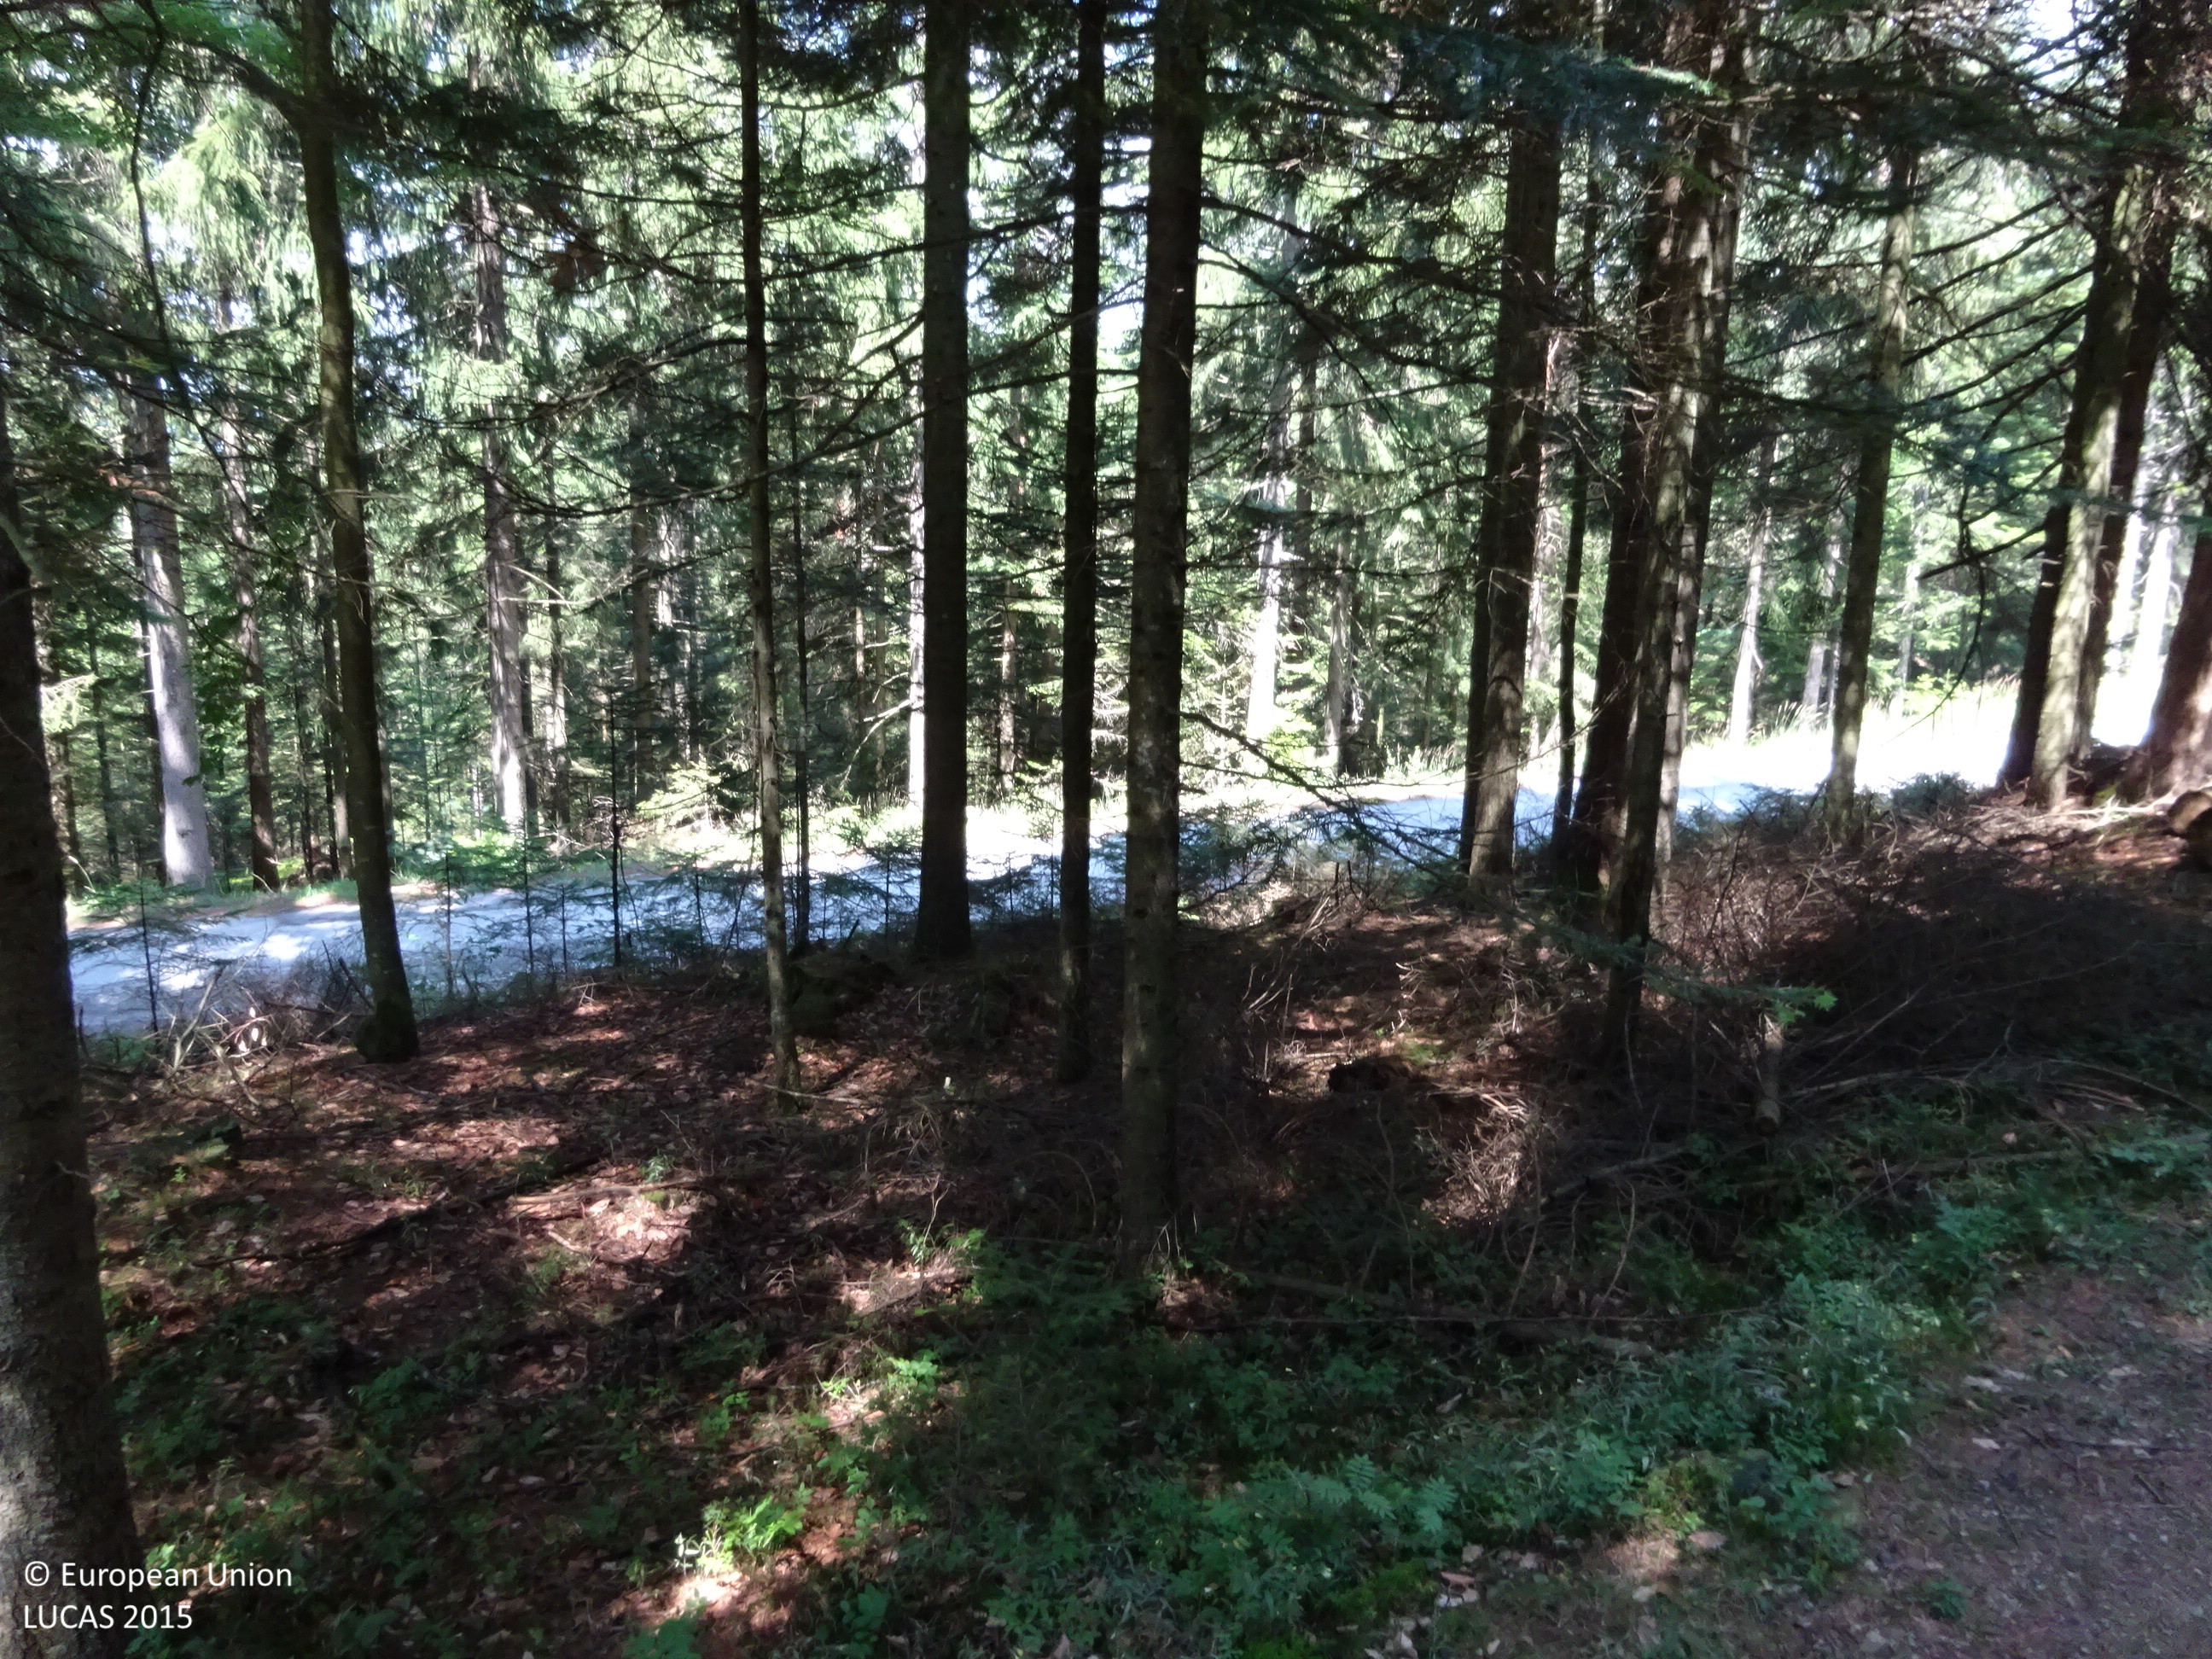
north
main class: Woodland
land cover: Spruce dominated coniferous woodland
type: alpine coniferous forest
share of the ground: > 75 %
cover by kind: coniferous forest trees 100 %
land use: Forestry
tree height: > 5 m
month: August
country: AT
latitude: 47.3347
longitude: 15.7314
